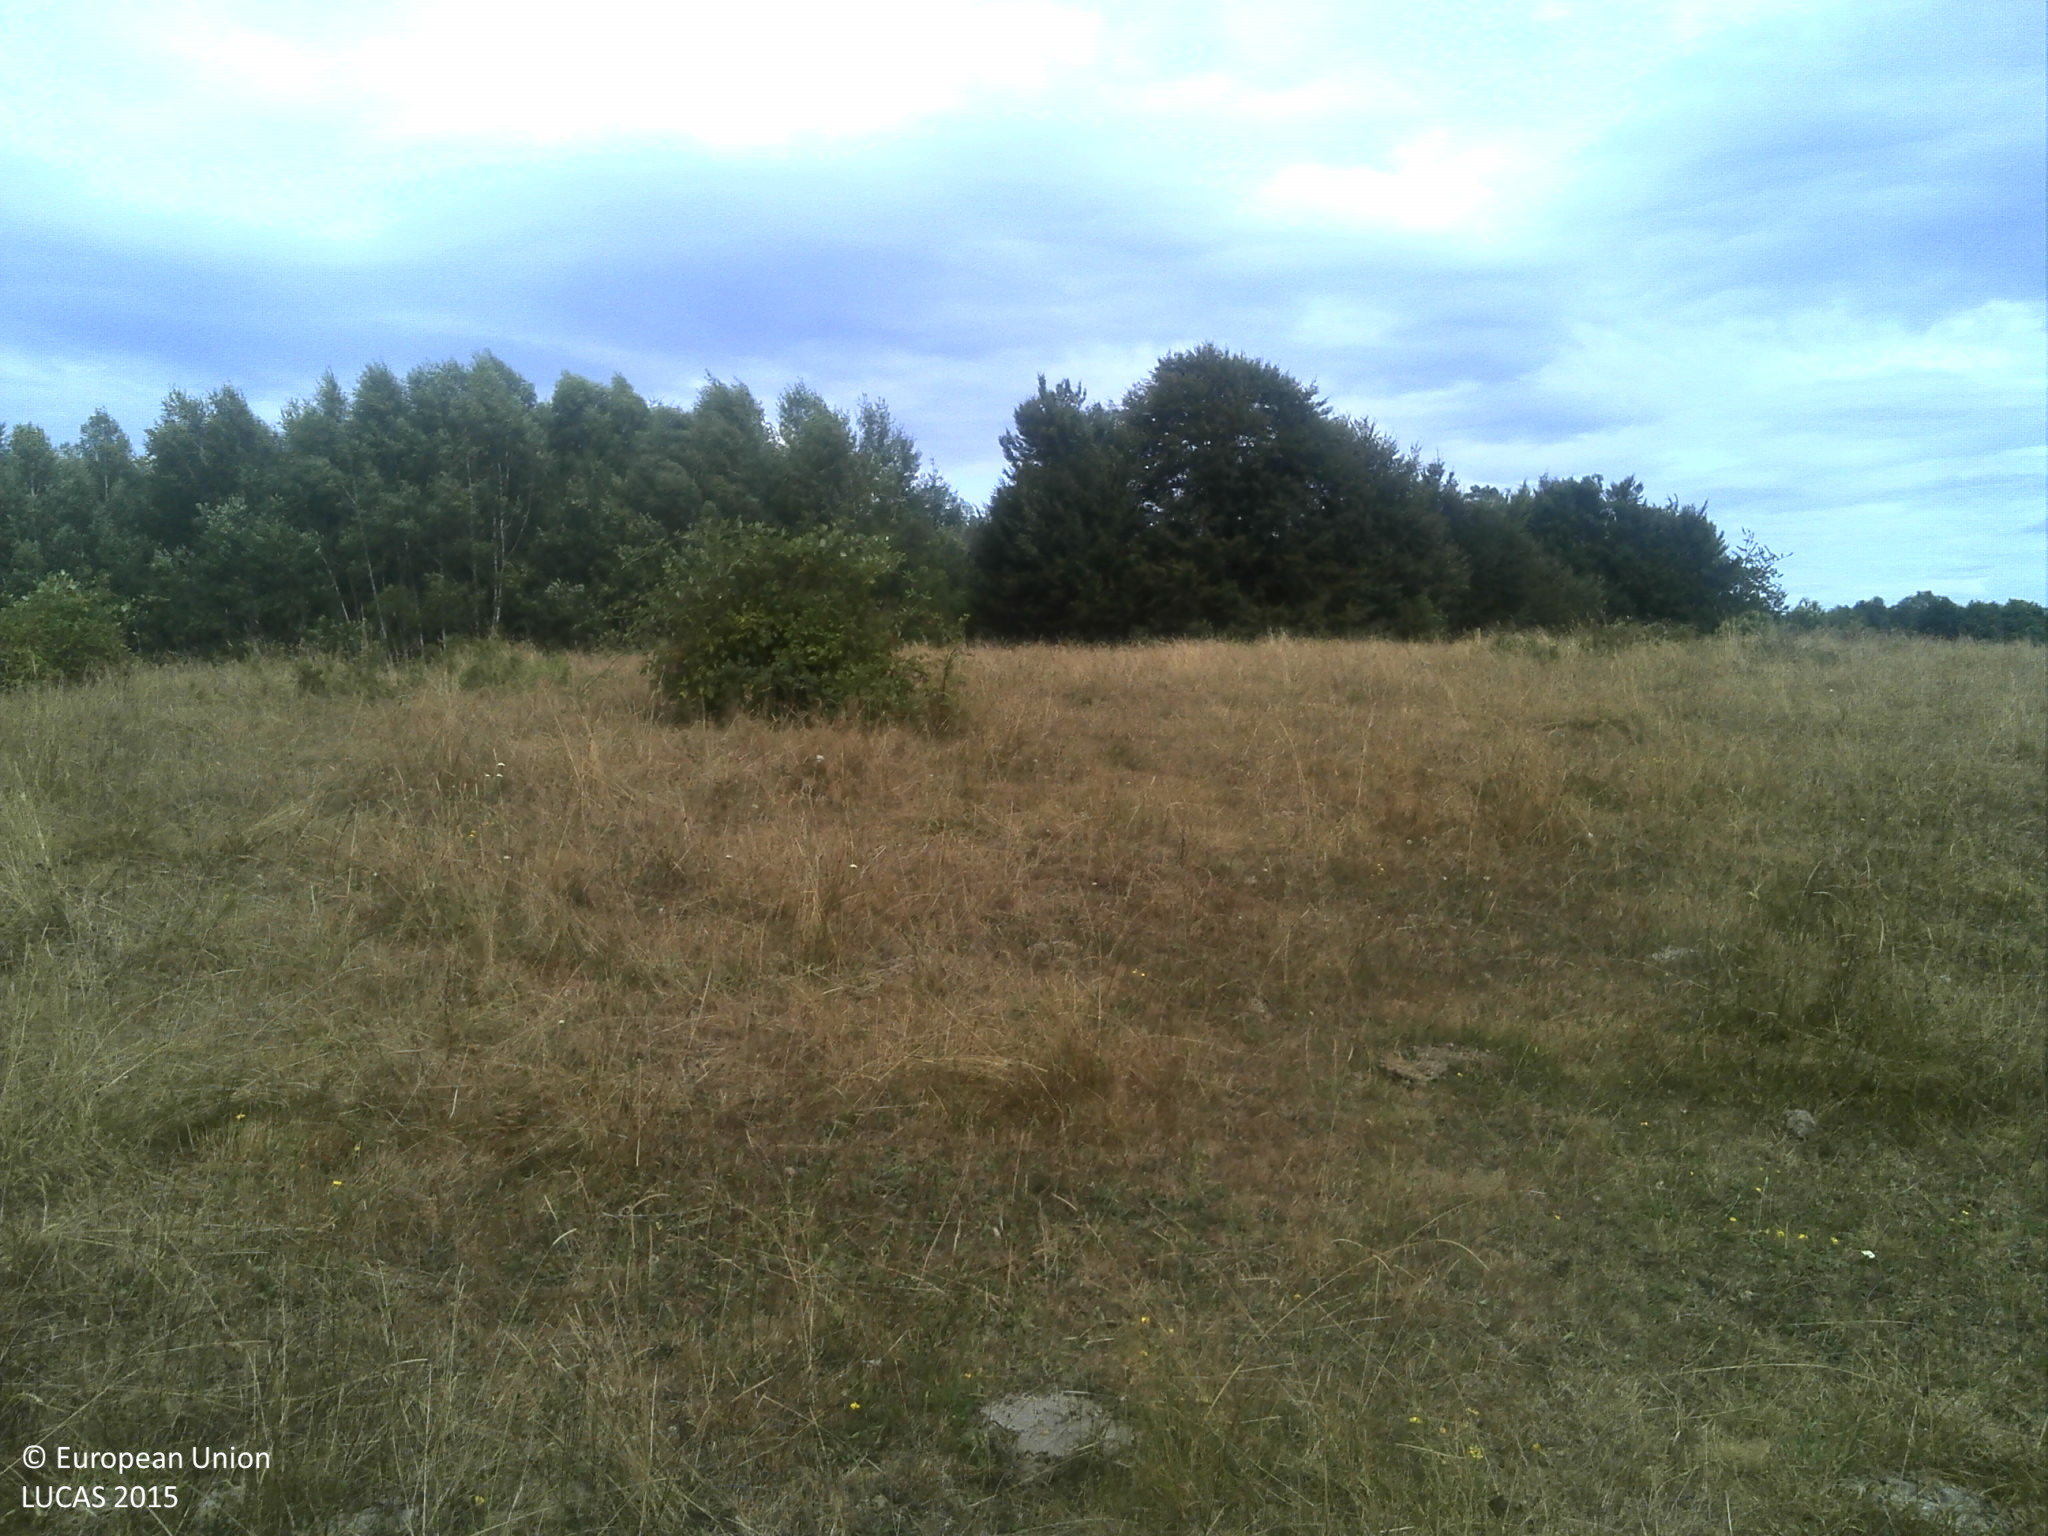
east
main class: Grassland
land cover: Grassland without tree/shrub cover
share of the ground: > 75 %
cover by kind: herbaceous plants 100 %
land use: Agriculture (excluding fallow land and kitchen gardens)
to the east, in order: Grassland without tree/shrub cover; Fences; Spruce dominated mixed woodland; Rivers and streams; Broadleaved woodland; Pine dominated mixed woodland
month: July
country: FR
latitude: 45.1760
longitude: 1.9169
